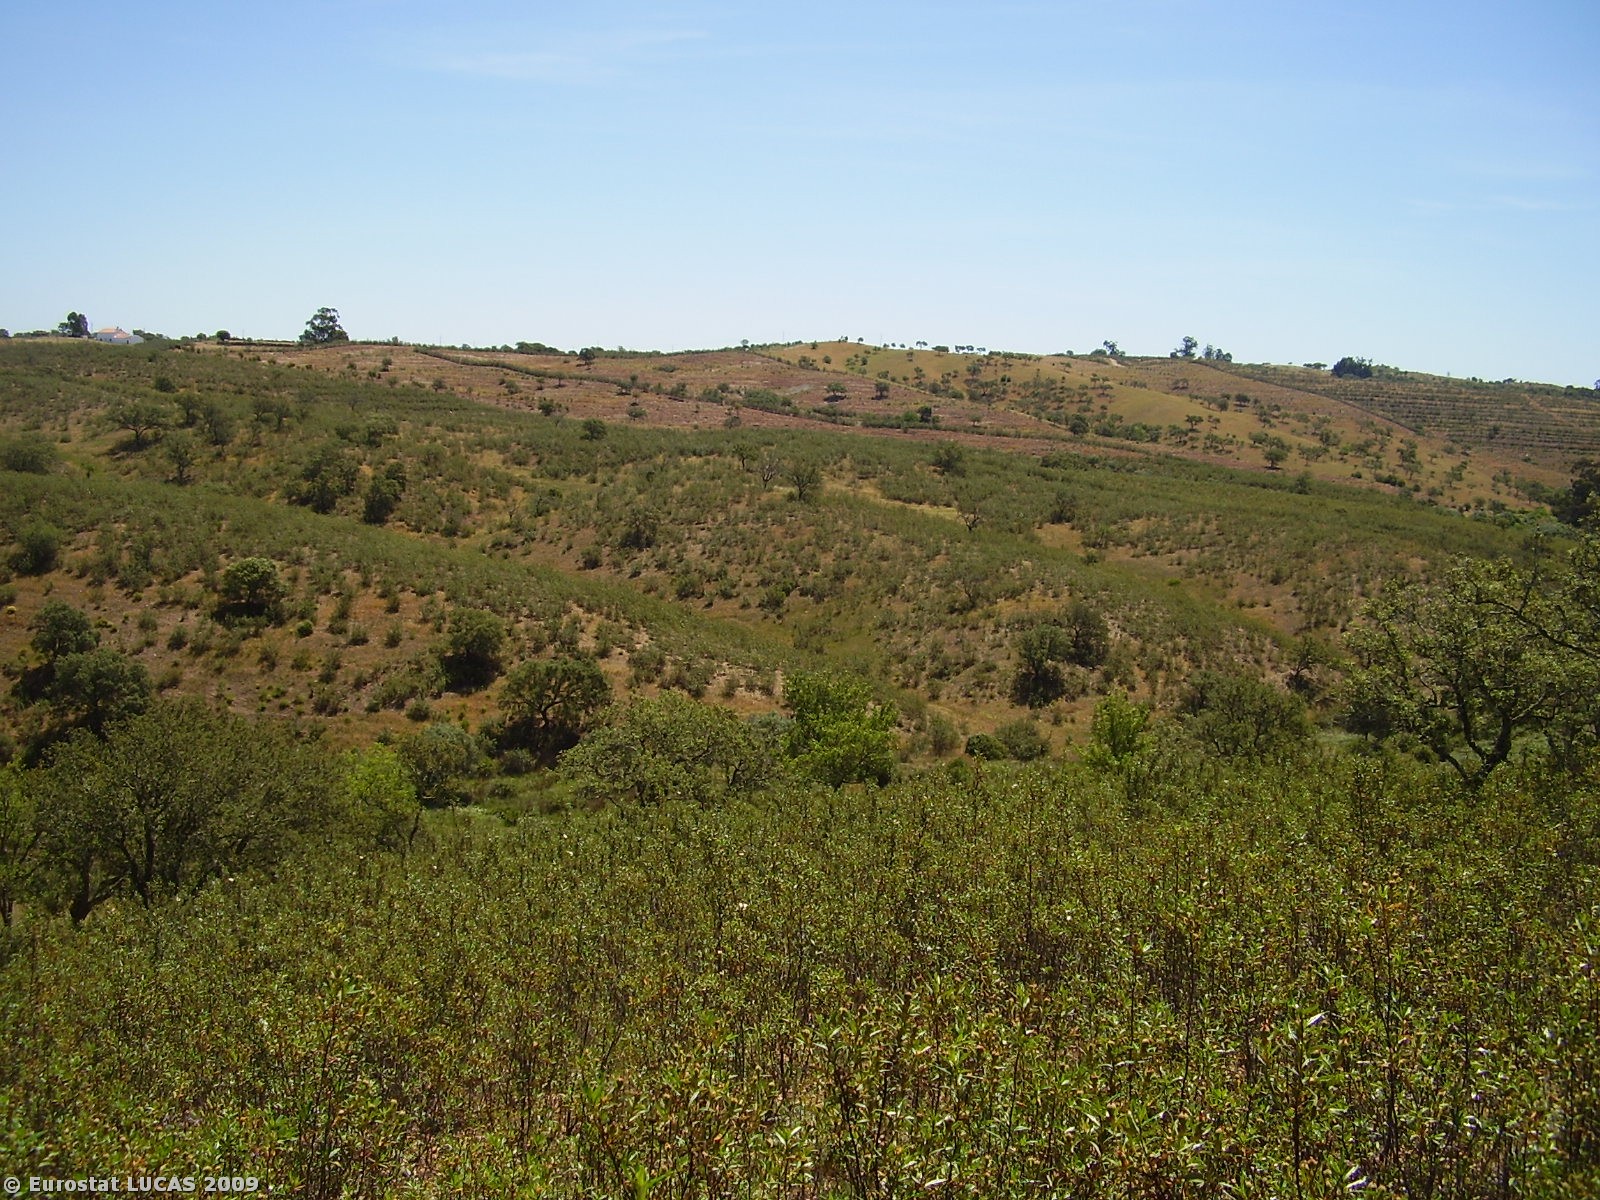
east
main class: Shrubland
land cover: Shrubland with sparse tree cover
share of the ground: > 75 %
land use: Fallow land
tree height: > 5 m
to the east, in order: Shrubland with sparse tree cover; Single bushes/trees; Shrubland with sparse tree cover; Rivers and streams; Shrubland with sparse tree cover; Single bushes/trees
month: May
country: PT
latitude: 37.4938
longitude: -8.2011
